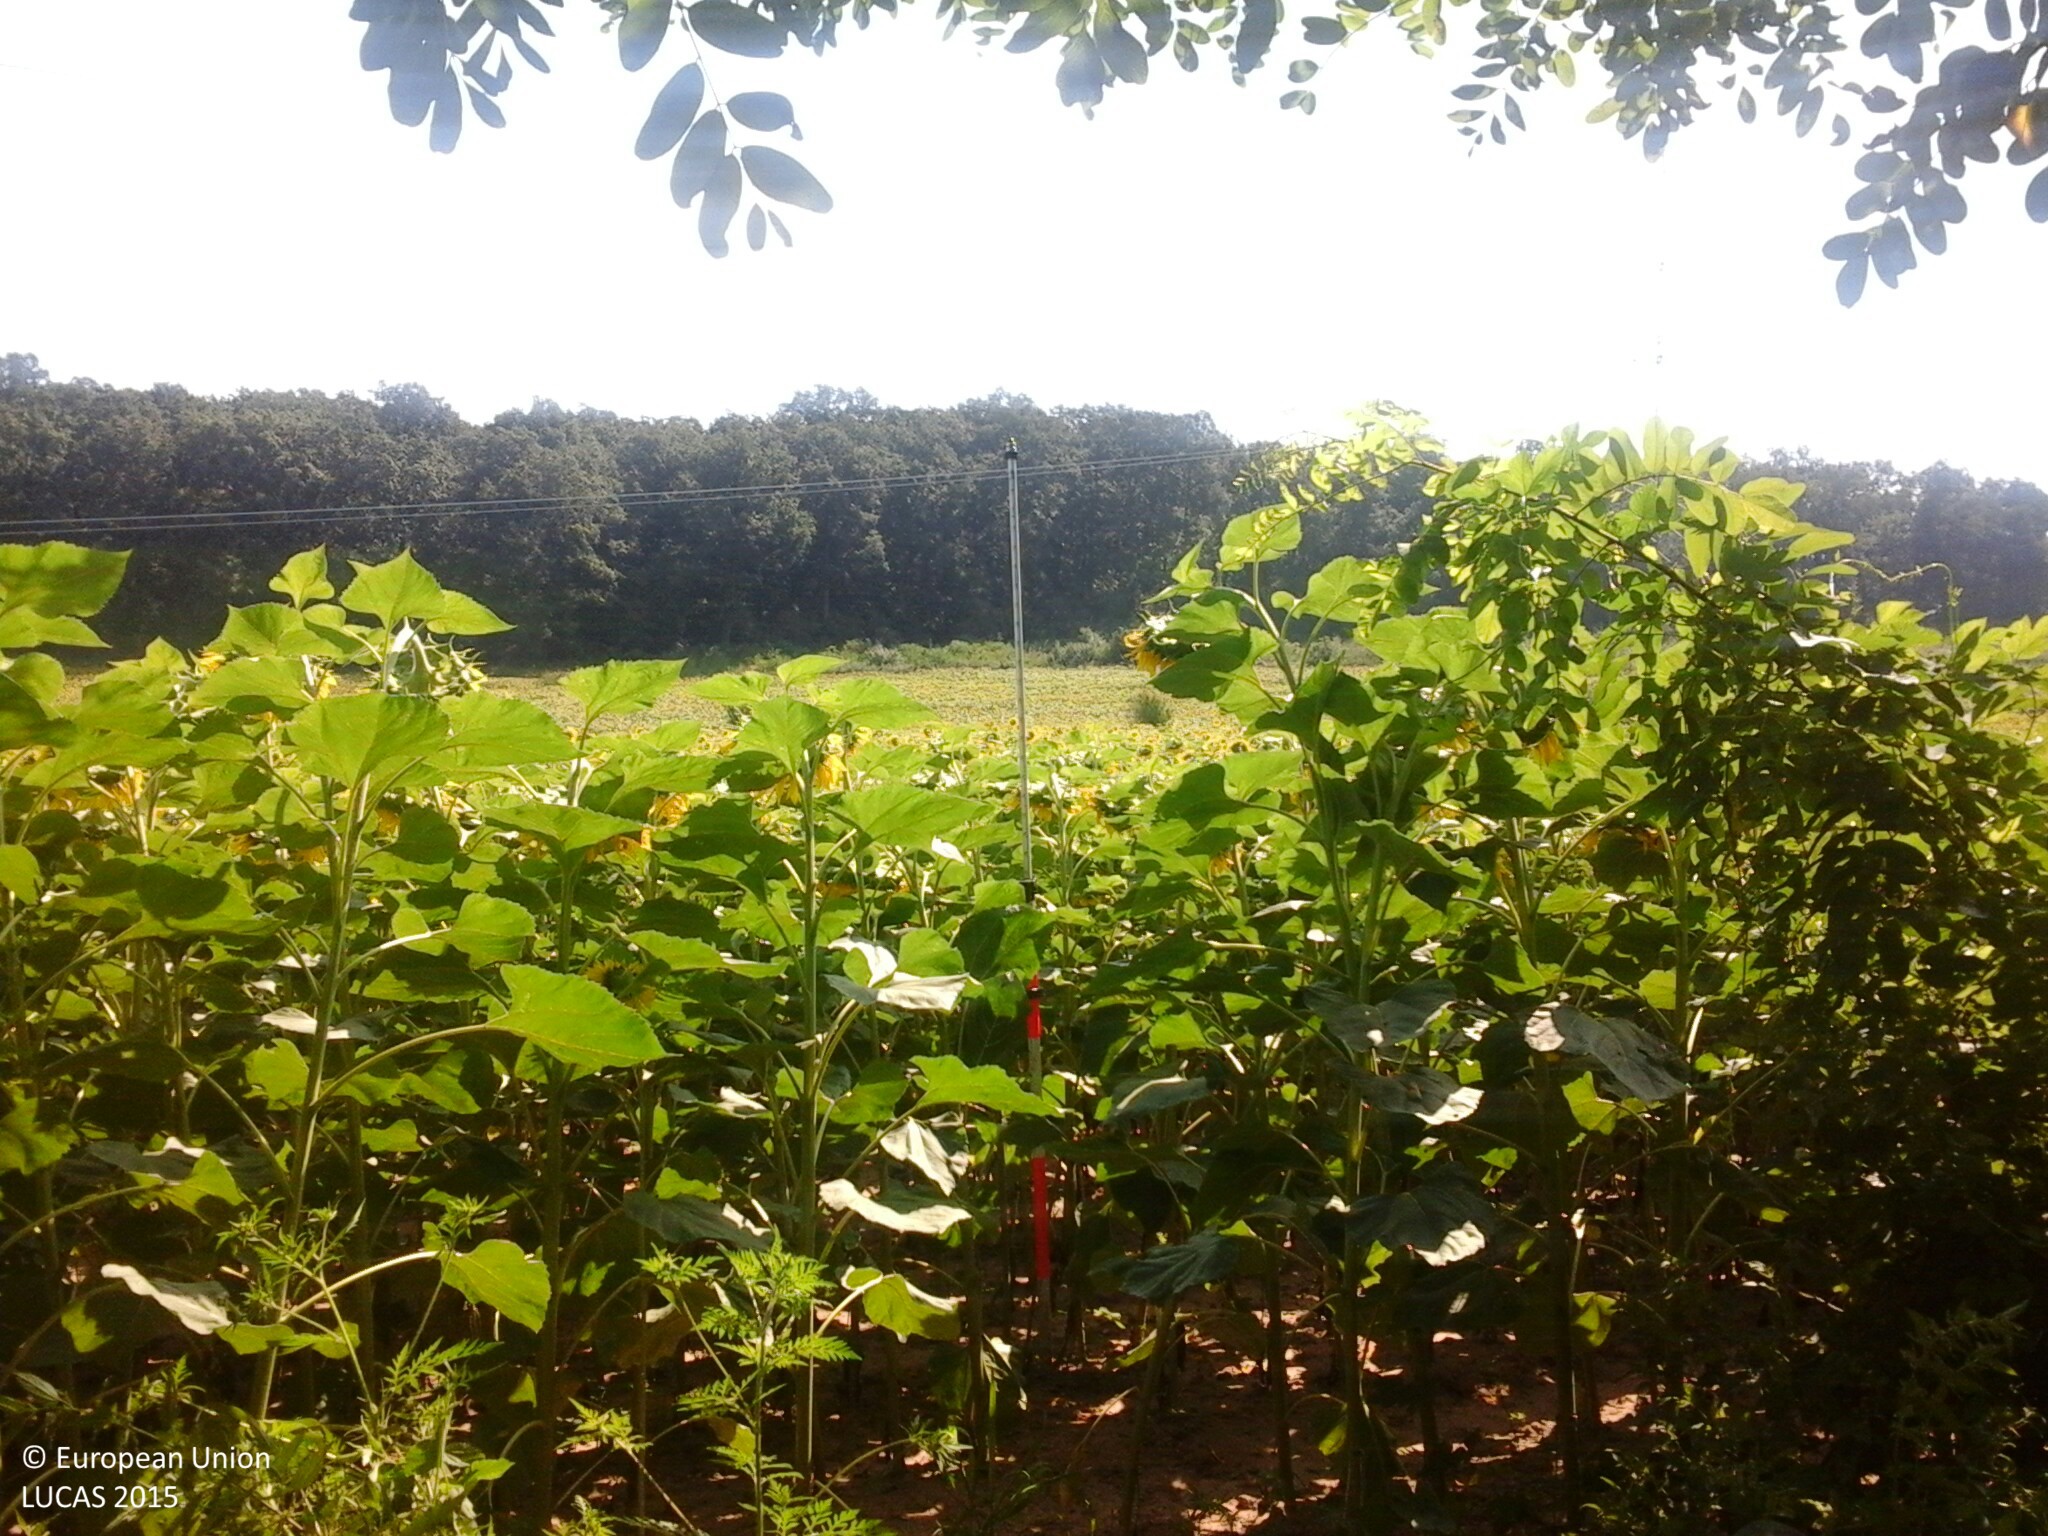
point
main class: Cropland
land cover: Sunflower
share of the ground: > 75 %
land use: Agriculture (excluding fallow land and kitchen gardens)
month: August
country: HU
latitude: 47.4914
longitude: 18.3350
